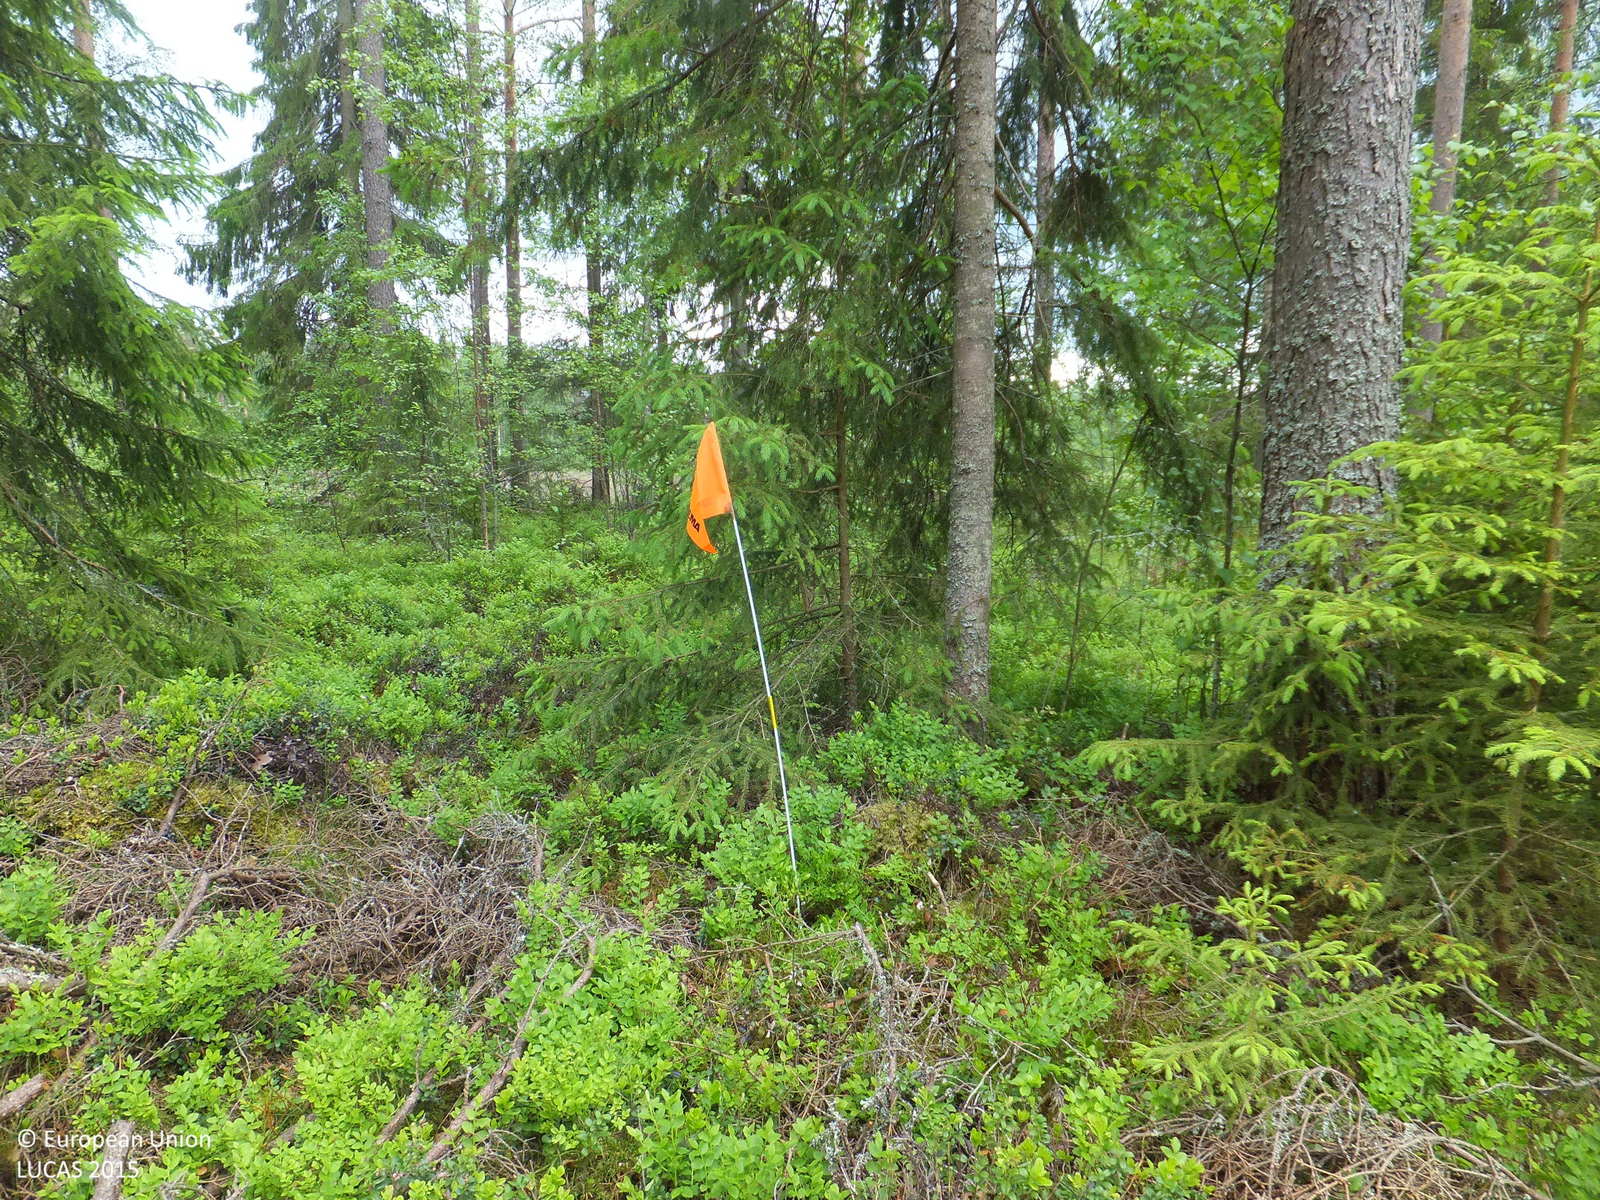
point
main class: Woodland
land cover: Other mixed woodland
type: boreal forest
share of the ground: > 75 %
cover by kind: coniferous forest trees 55 %, broadleaved forest trees 20 %, shrubs 15 %, lichens and mosses 10 %
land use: Forestry
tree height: > 5 m
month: June
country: FI
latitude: 63.4877
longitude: 24.1080
